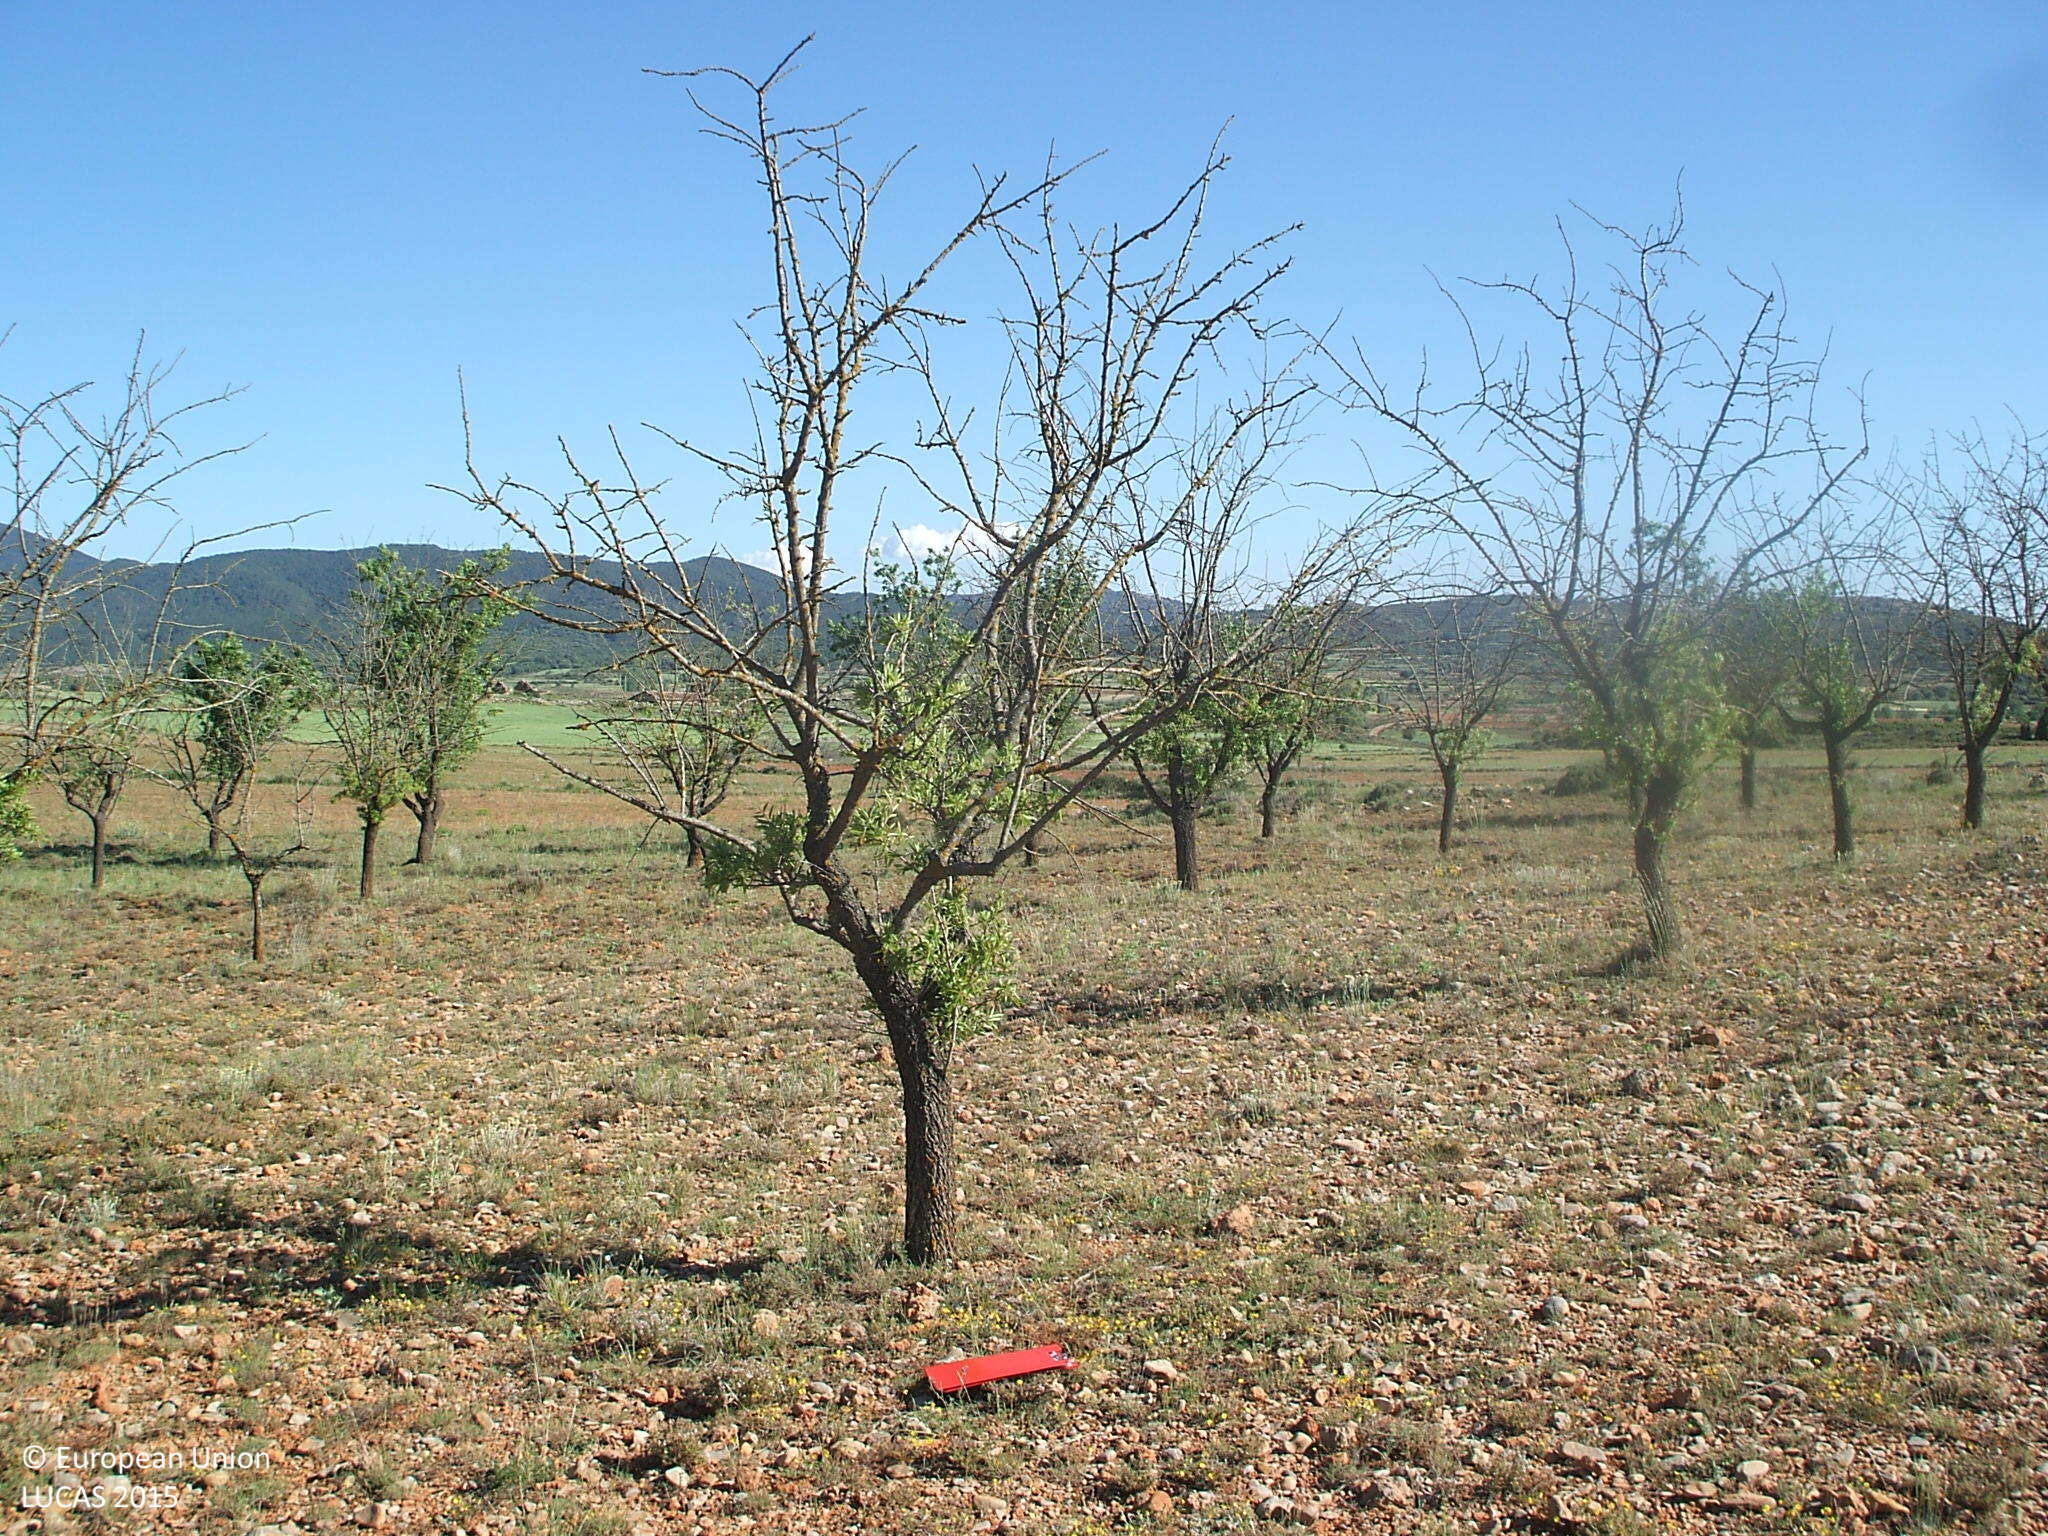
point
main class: Cropland
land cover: Nuts trees
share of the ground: 10 - 25 %
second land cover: Spontaneously vegetated surfaces
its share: 25 - 50 %
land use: Agriculture (excluding fallow land and kitchen gardens)
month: May
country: ES
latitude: 40.0829
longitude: -0.6890
